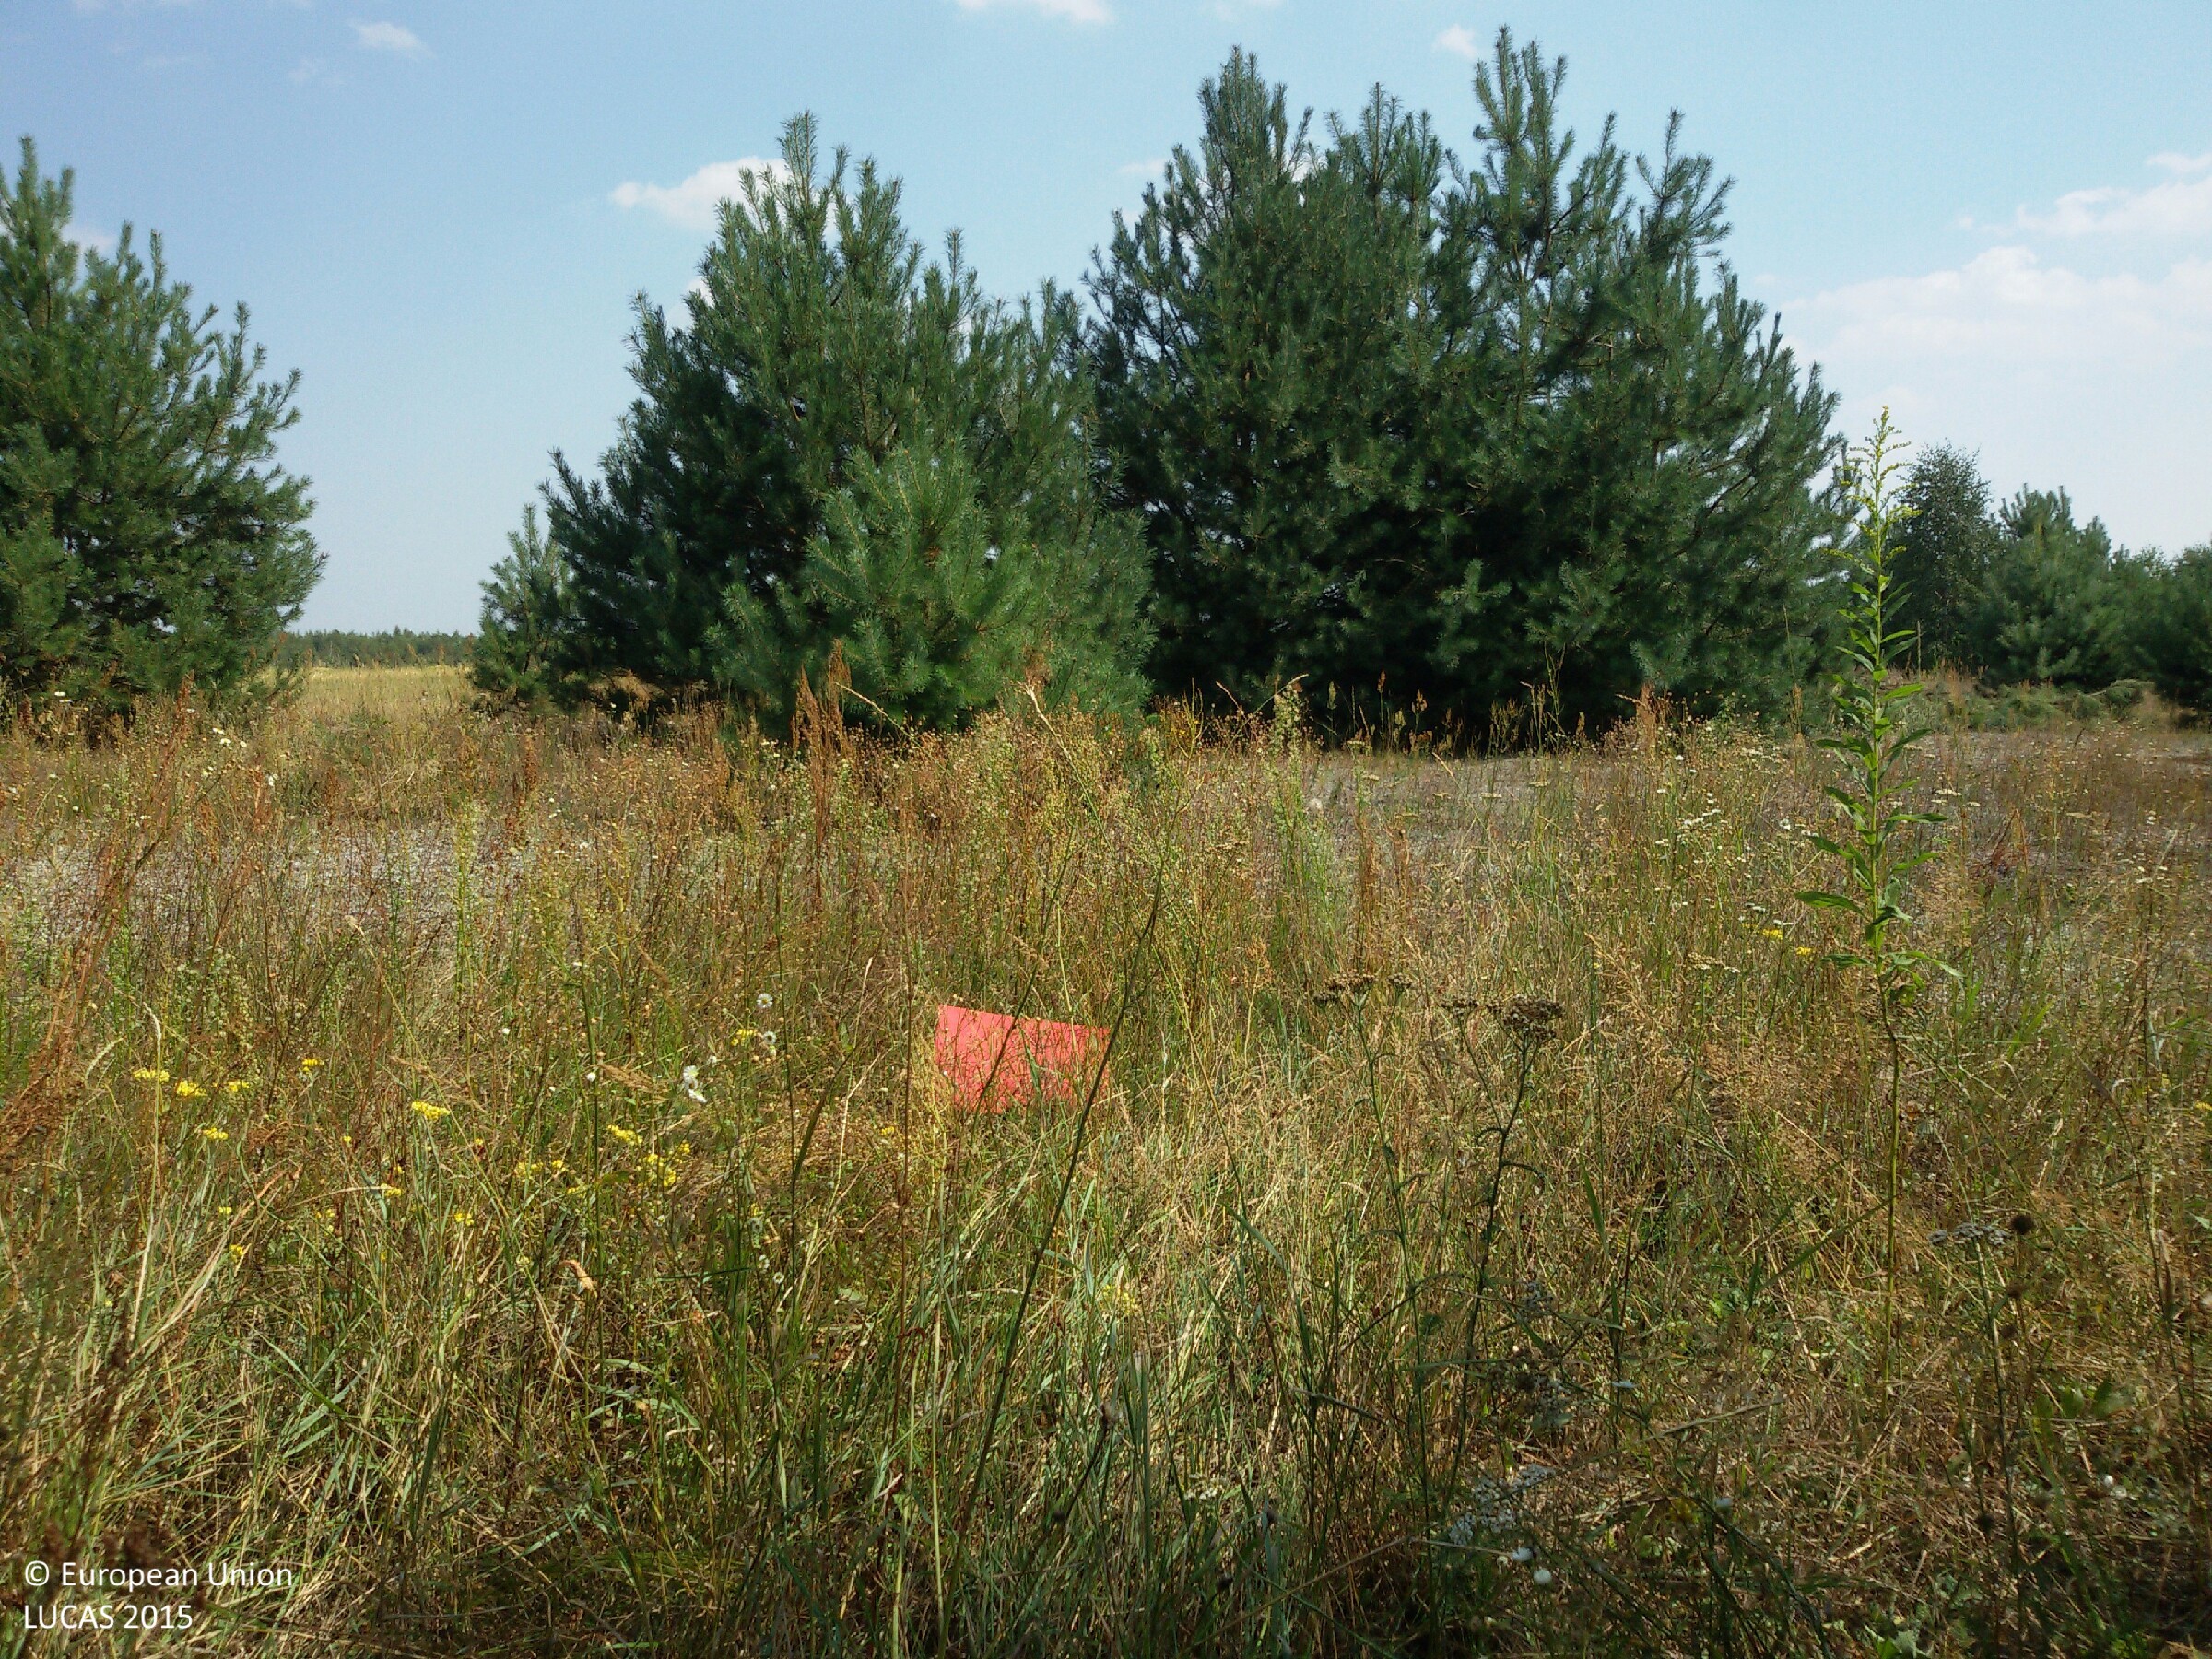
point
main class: Woodland
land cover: Pine dominated coniferous woodland
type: hemiboreal forest and nemoral coniferous forest and mixed broadleaved-coniferous forest
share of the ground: 25 - 50 %
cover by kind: herbaceous plants 45 %, coniferous forest trees 40 %, unconsolidated bare surface 10 %, lichens and mosses 5 %
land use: Abandoned areas
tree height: > 5 m
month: August
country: PL
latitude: 51.6410
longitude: 22.8317
